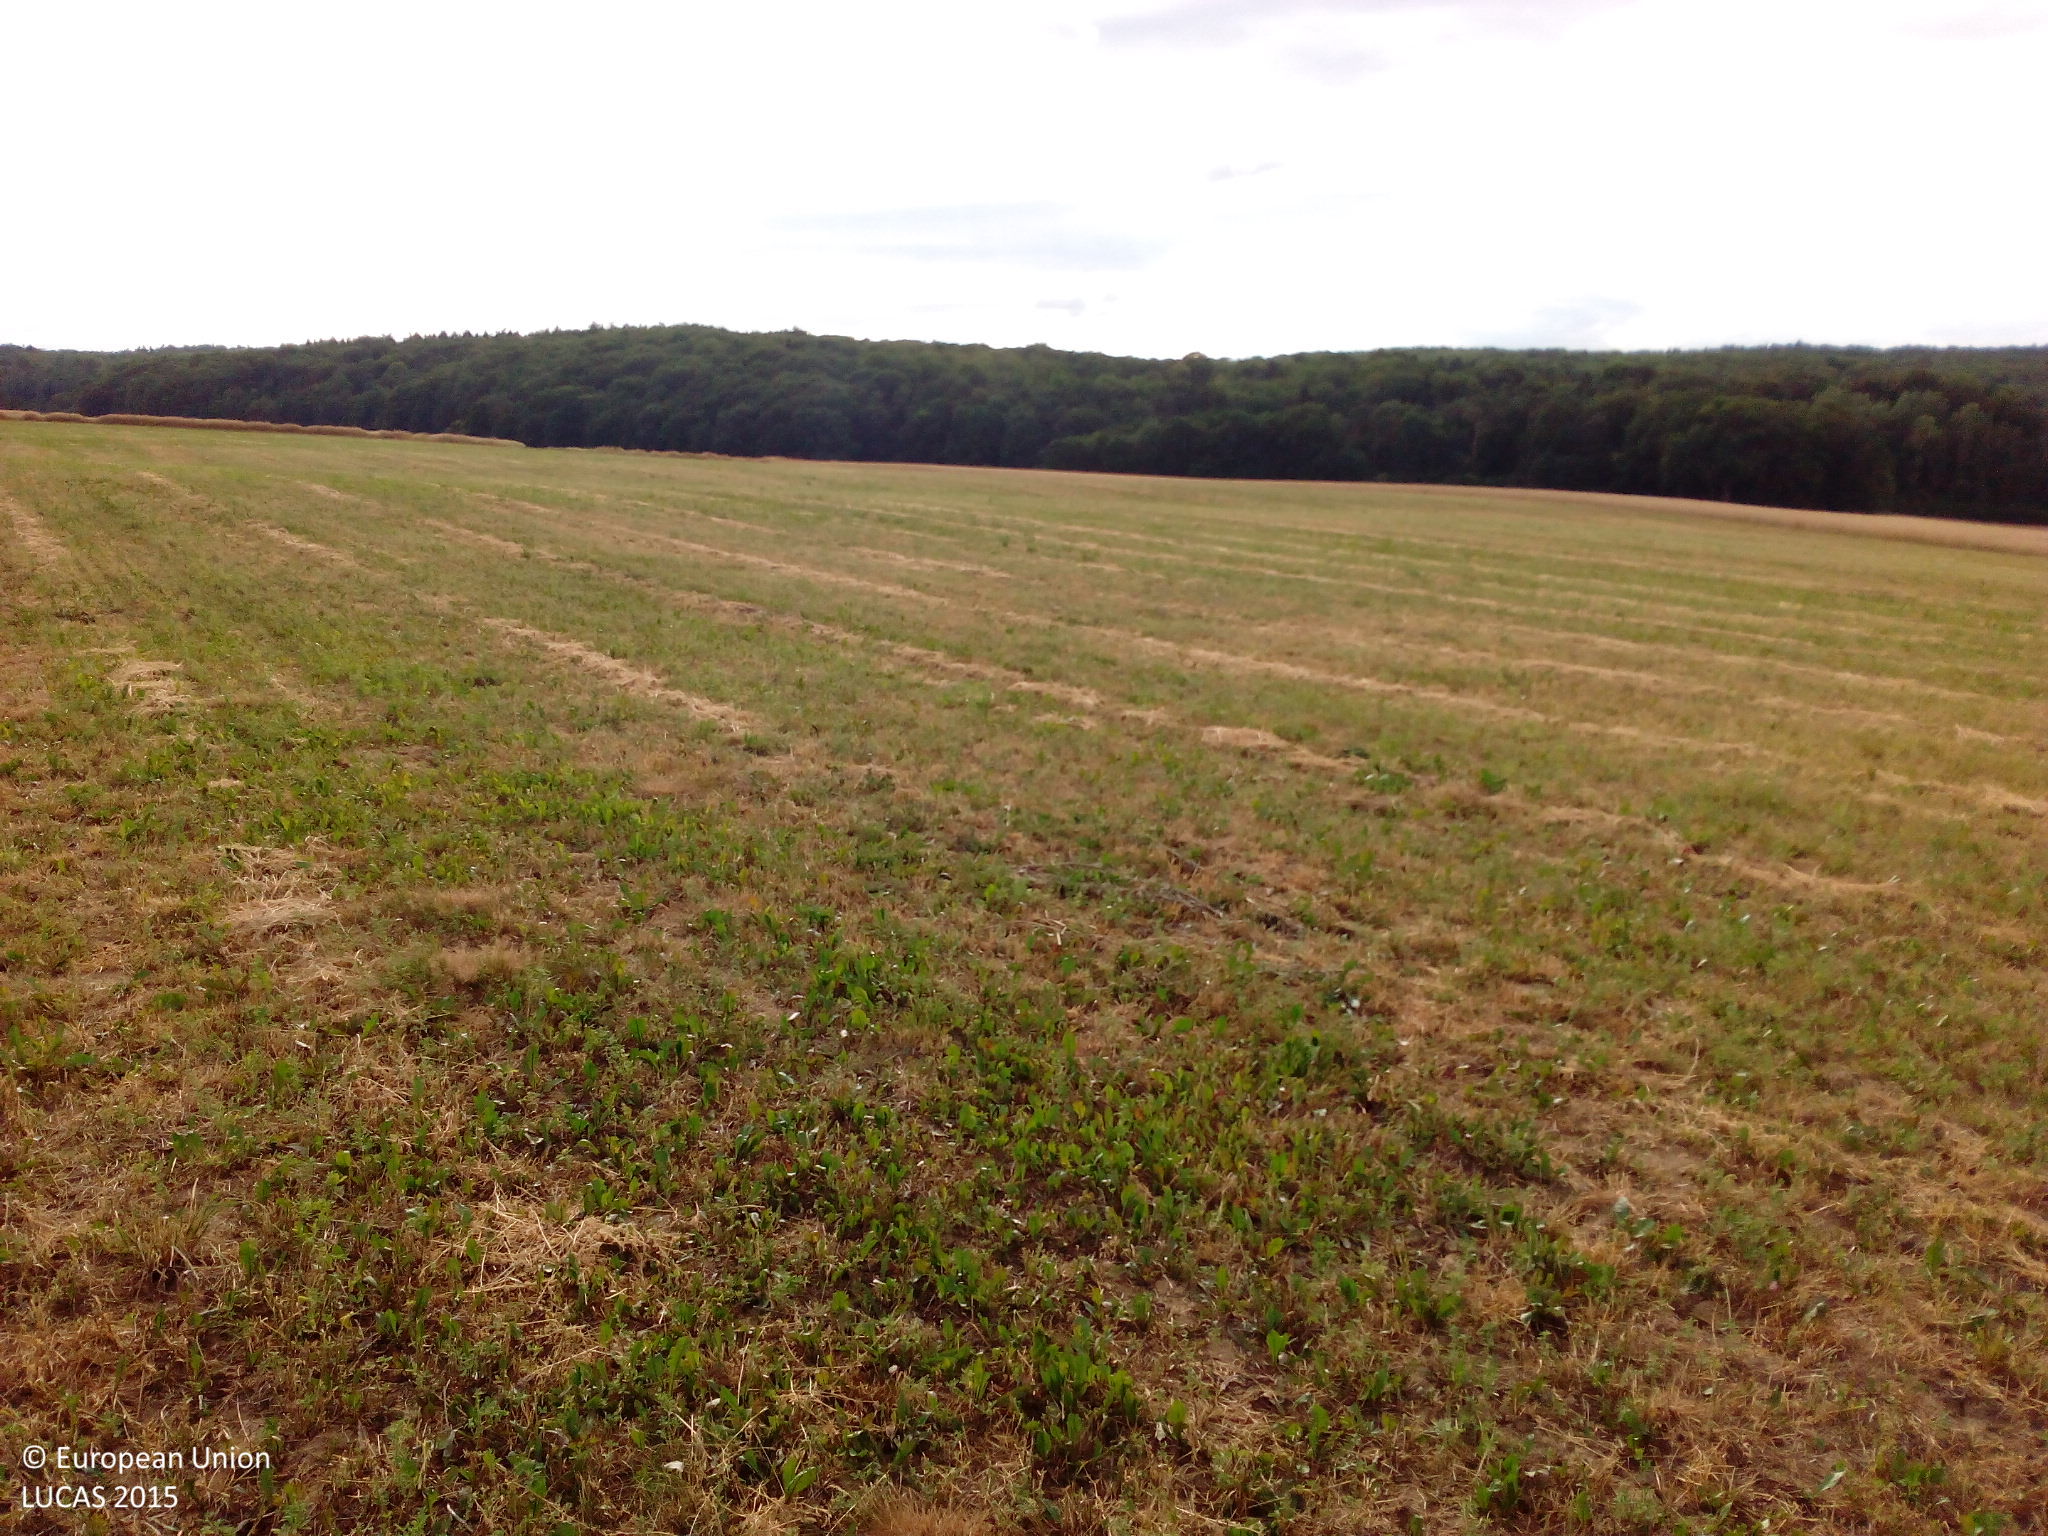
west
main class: Grassland
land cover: Grassland without tree/shrub cover
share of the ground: > 75 %
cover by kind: herbaceous plants 85 %, unconsolidated bare surface 15 %
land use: Agriculture (excluding fallow land and kitchen gardens)
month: July
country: DE
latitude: 49.7166
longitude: 9.9030
